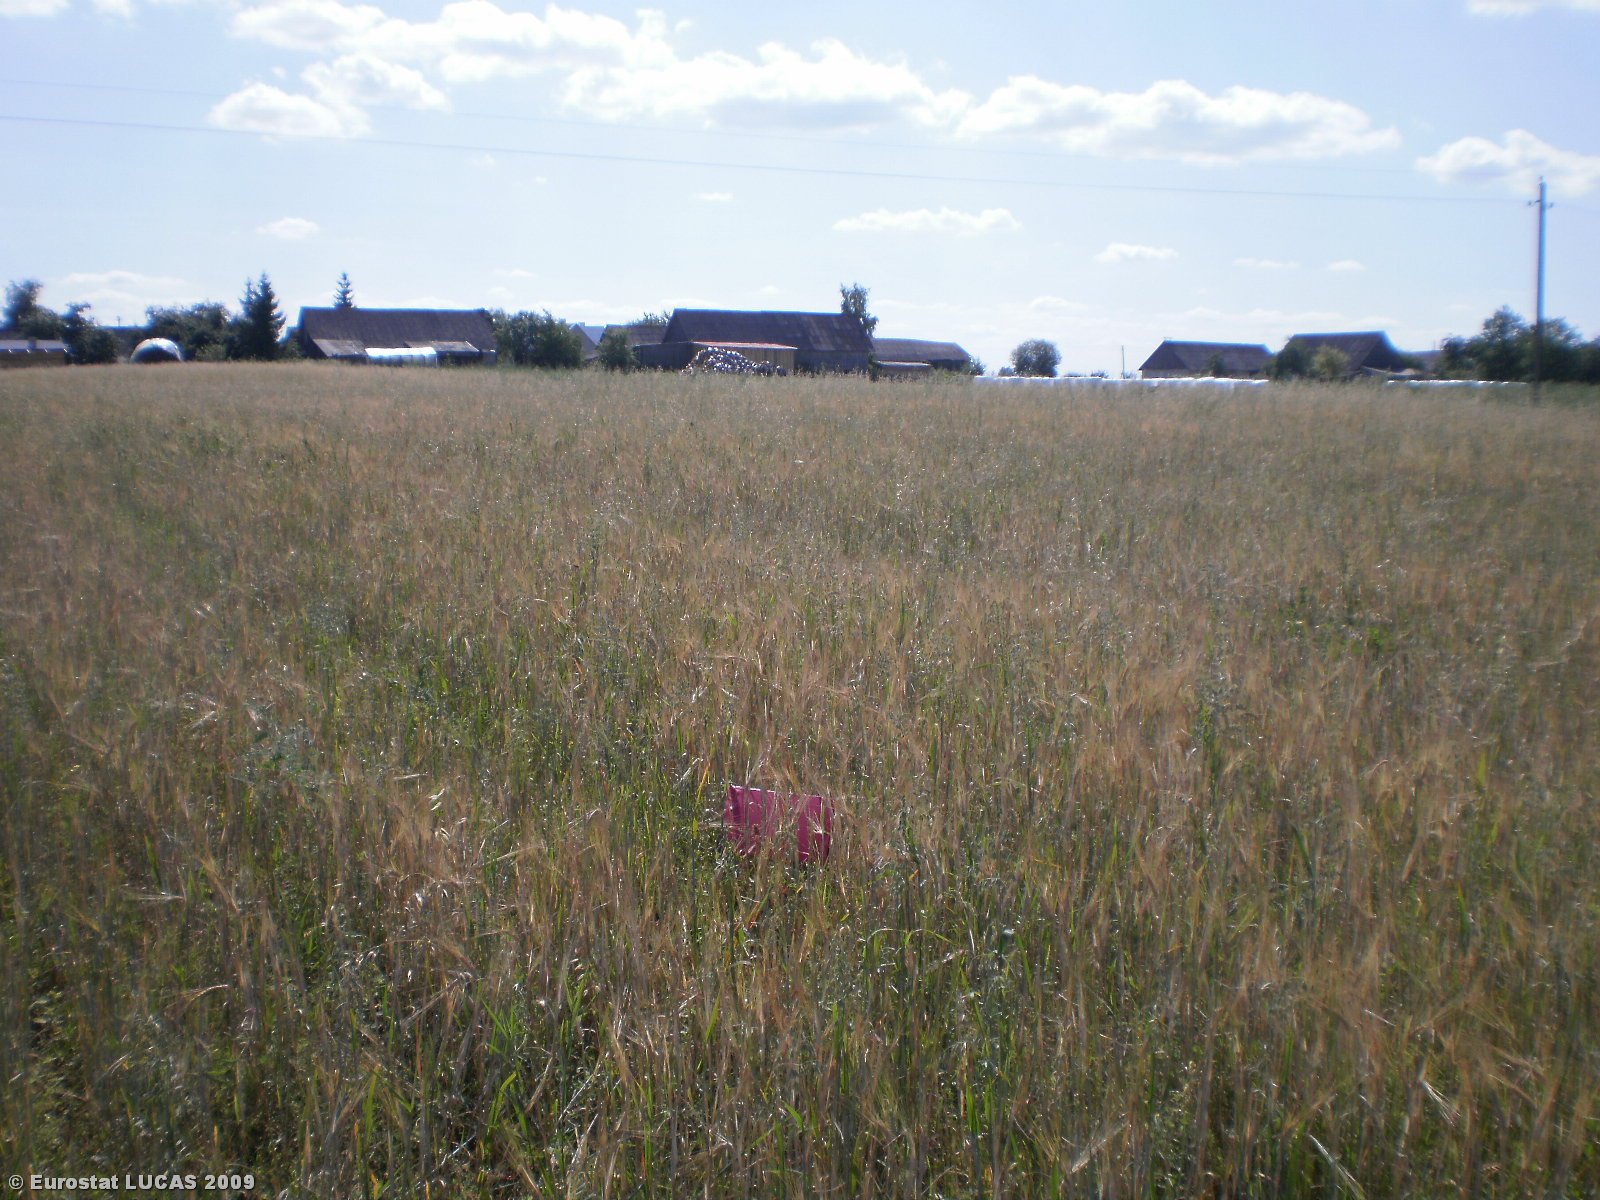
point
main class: Cropland
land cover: Barley
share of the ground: > 75 %
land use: Agriculture (excluding fallow land and kitchen gardens)
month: August
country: LT
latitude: 55.6257
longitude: 25.0246
